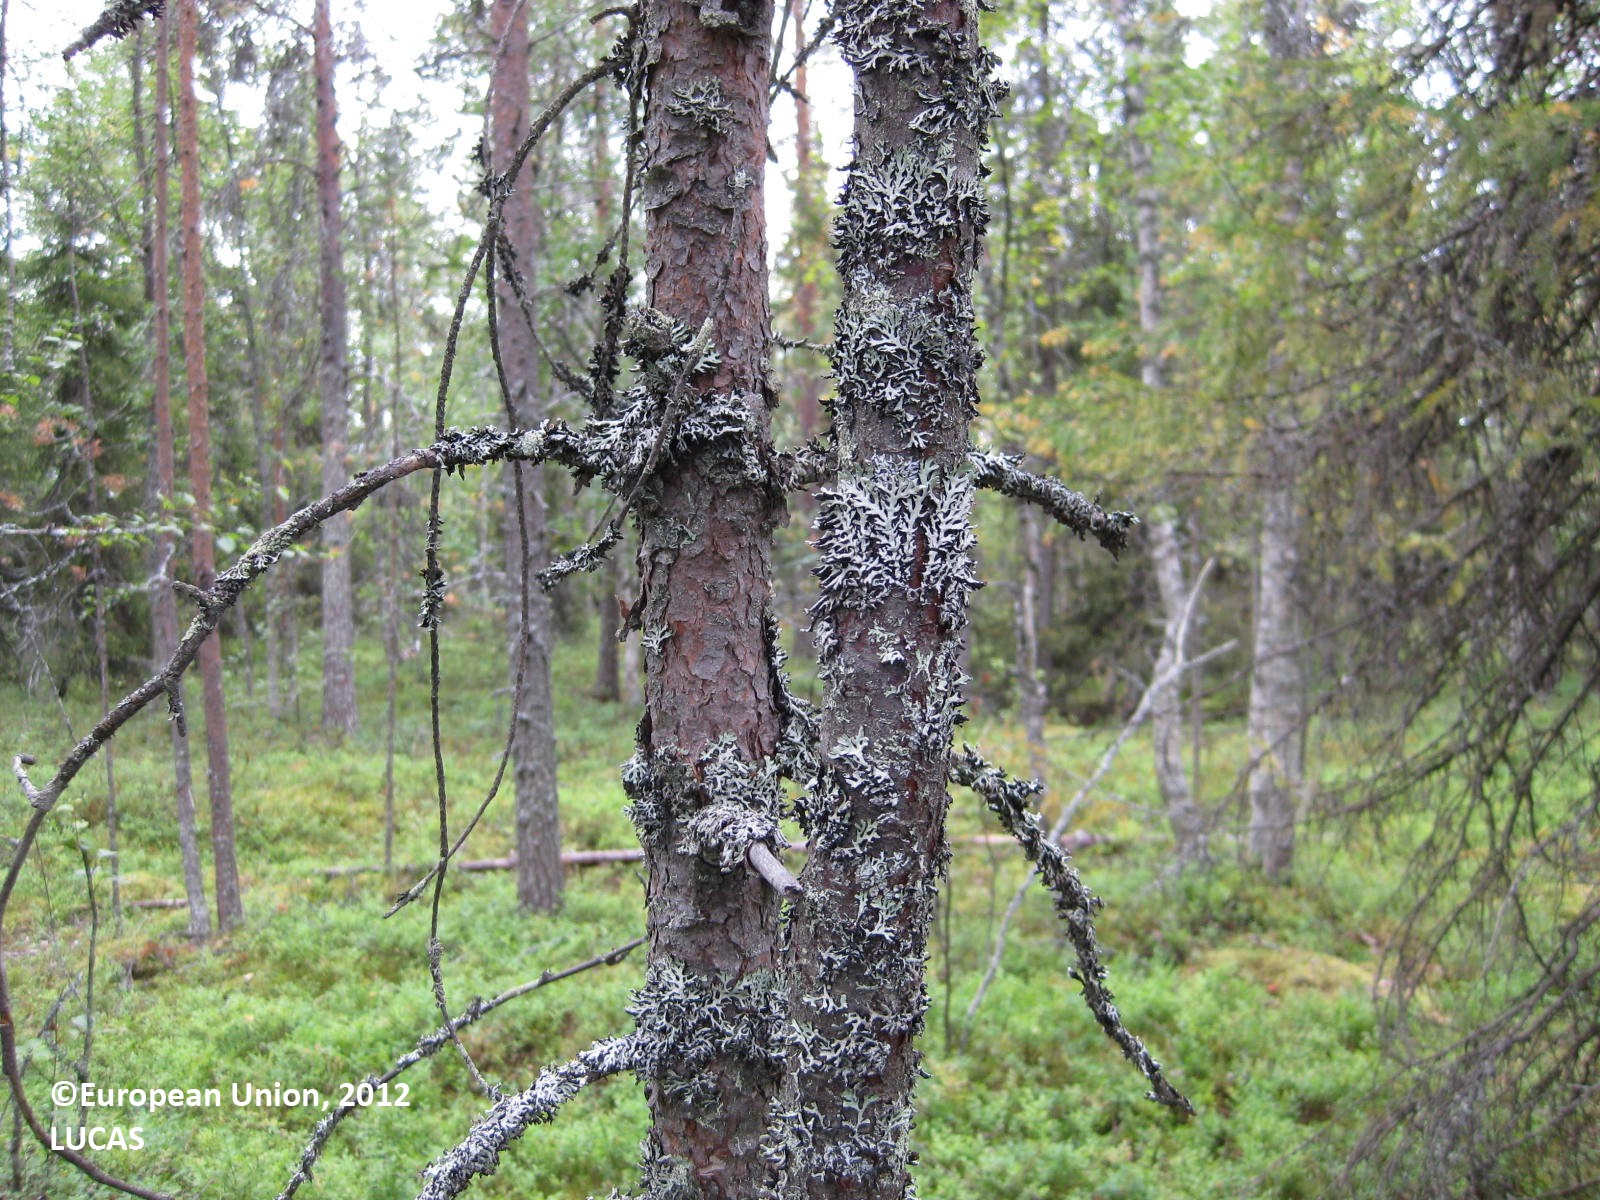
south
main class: Woodland
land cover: Pine dominated mixed woodland
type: boreal forest
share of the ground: 50 - 75 %
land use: Forestry
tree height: > 5 m
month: August
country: FI
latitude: 66.2839
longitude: 28.8556
